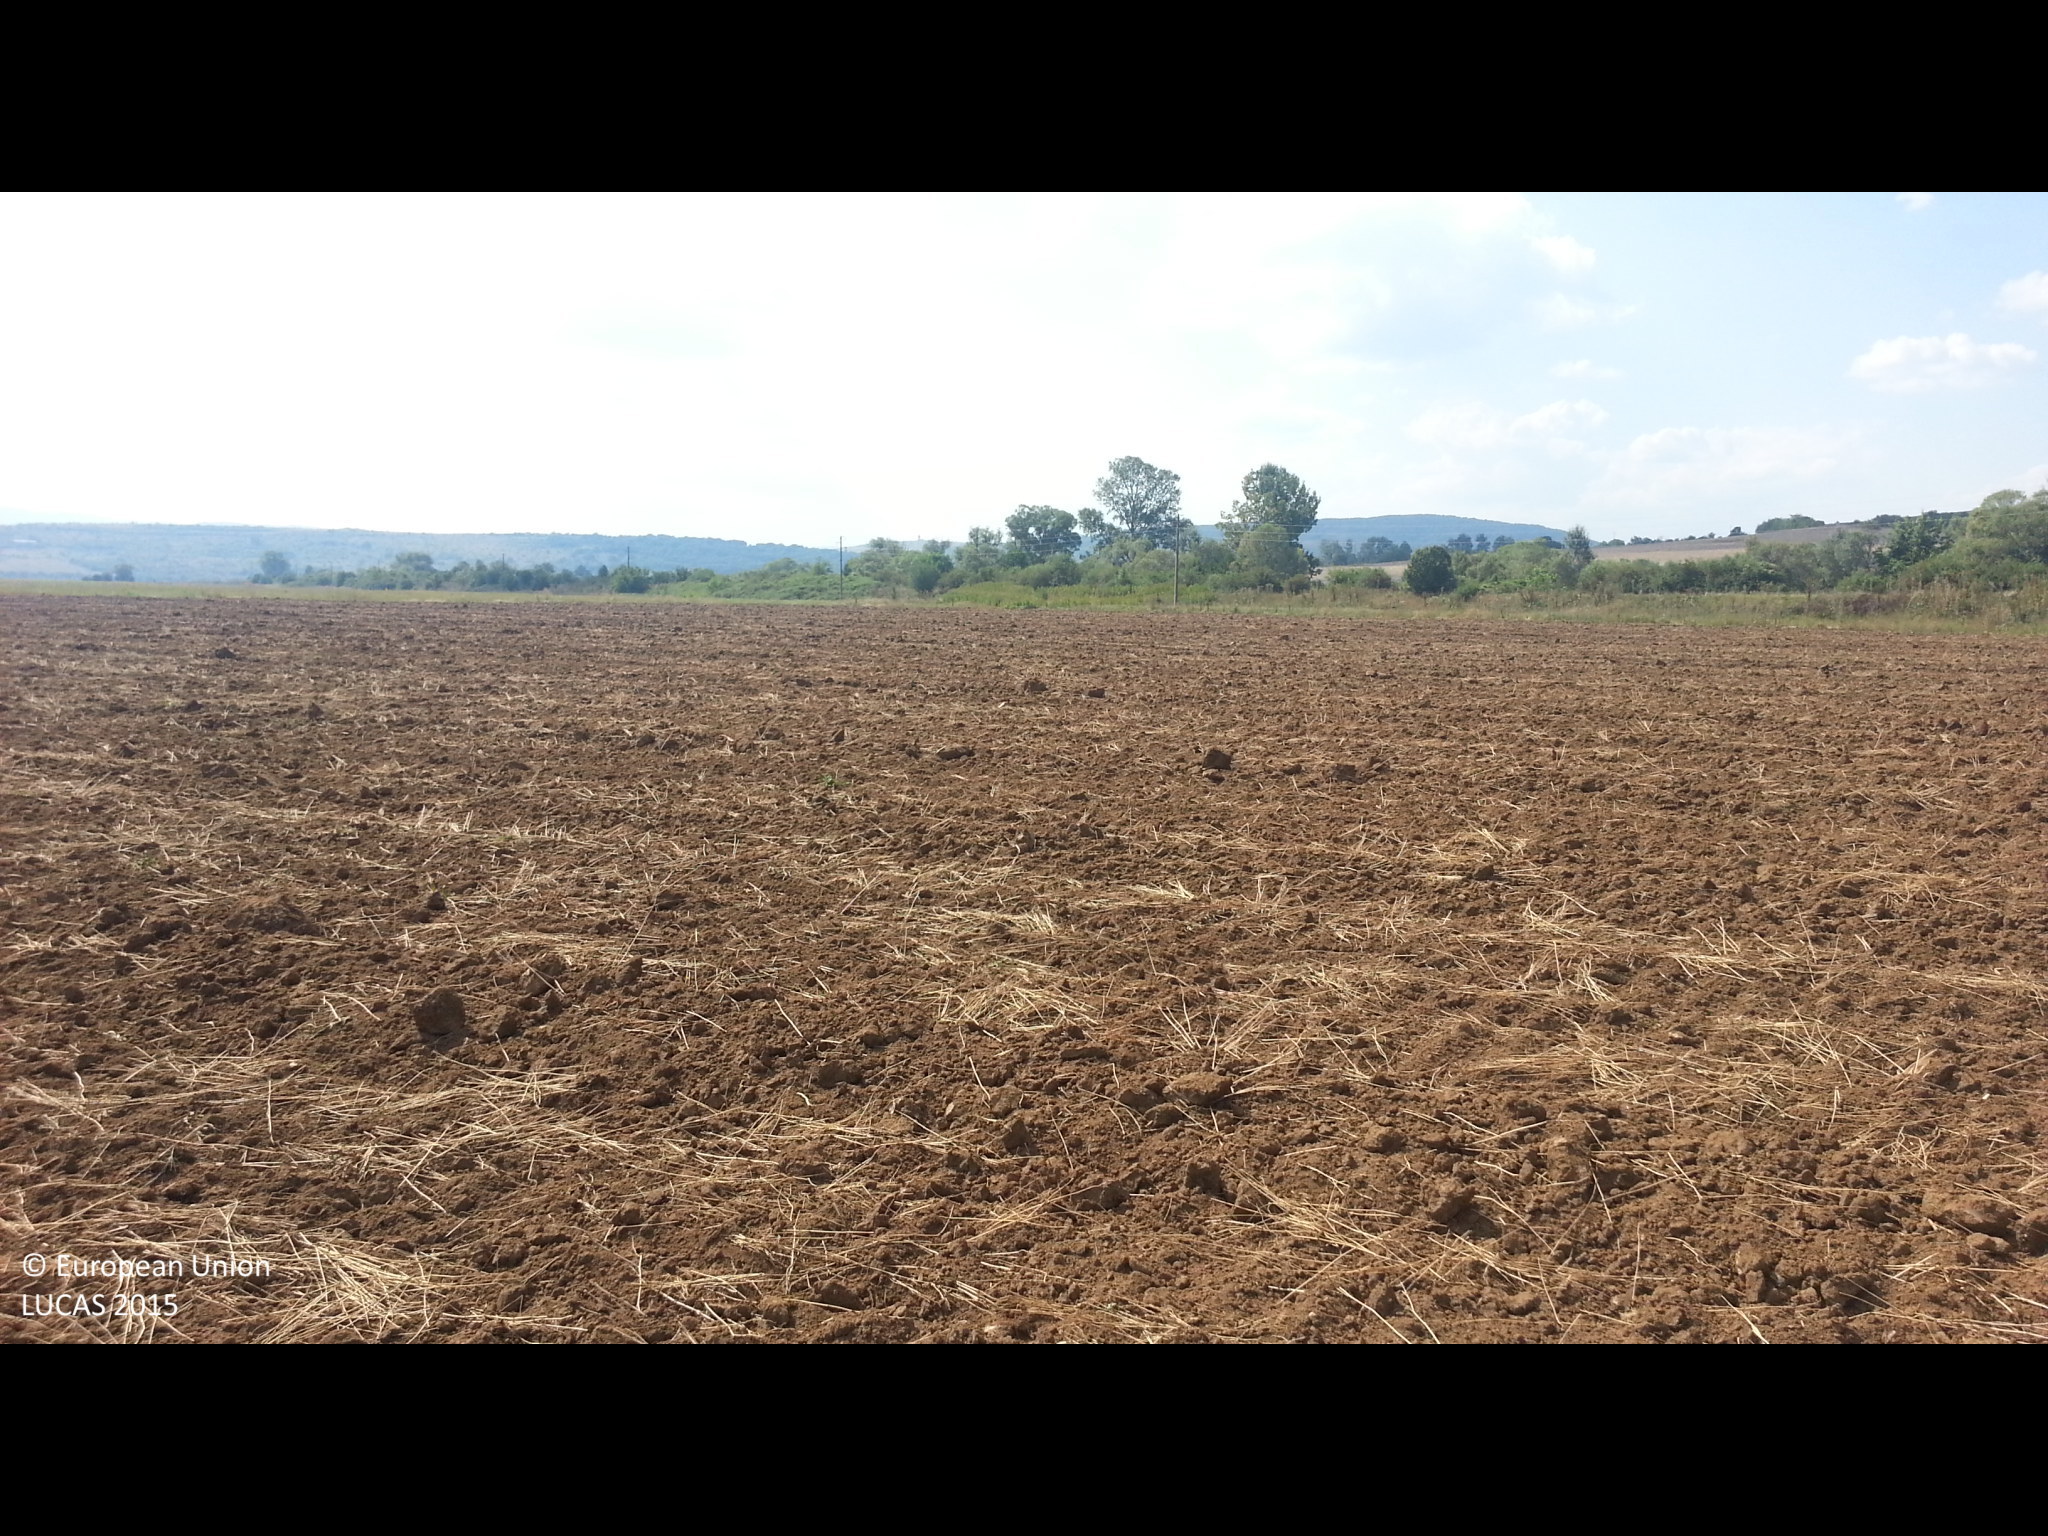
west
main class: Cropland
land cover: Common wheat
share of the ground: < 10 %
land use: Agriculture (excluding fallow land and kitchen gardens)
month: August
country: BG
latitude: 42.4963
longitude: 22.9370
